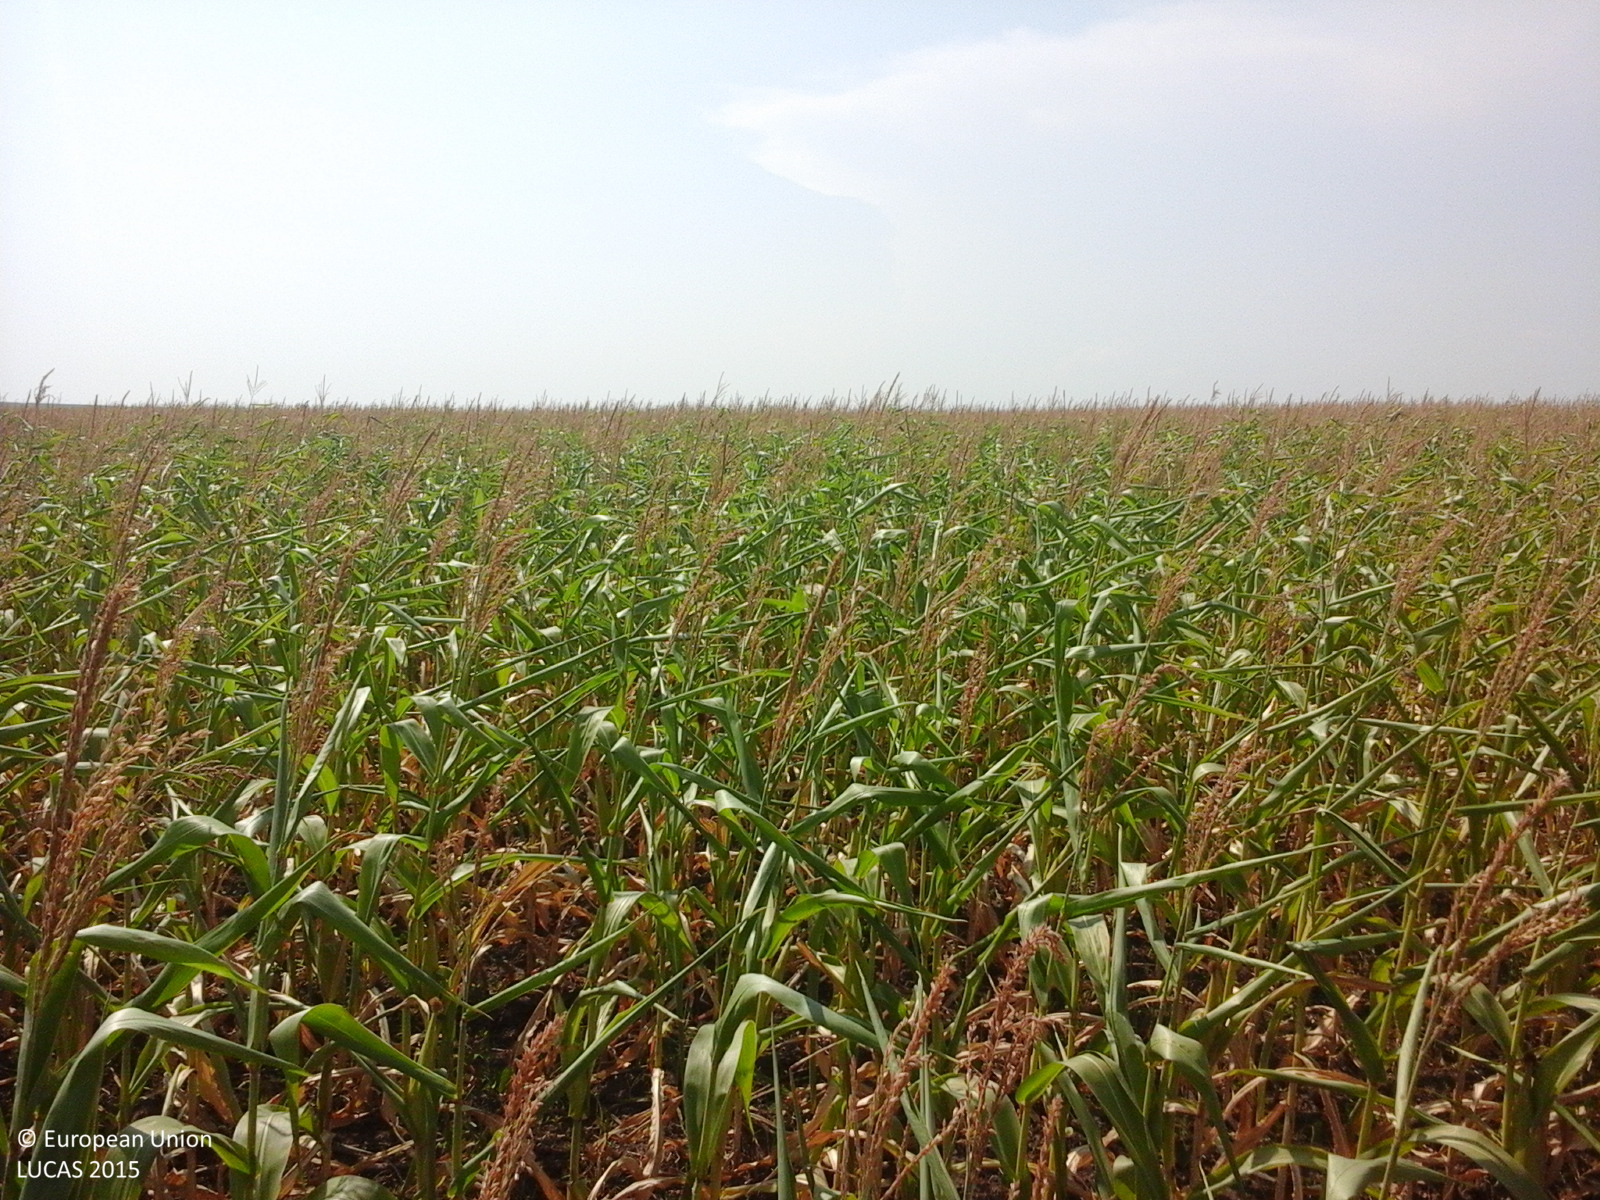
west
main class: Cropland
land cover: Maize
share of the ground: > 75 %
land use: Agriculture (excluding fallow land and kitchen gardens)
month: July
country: RO
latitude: 45.5910
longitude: 27.8413
